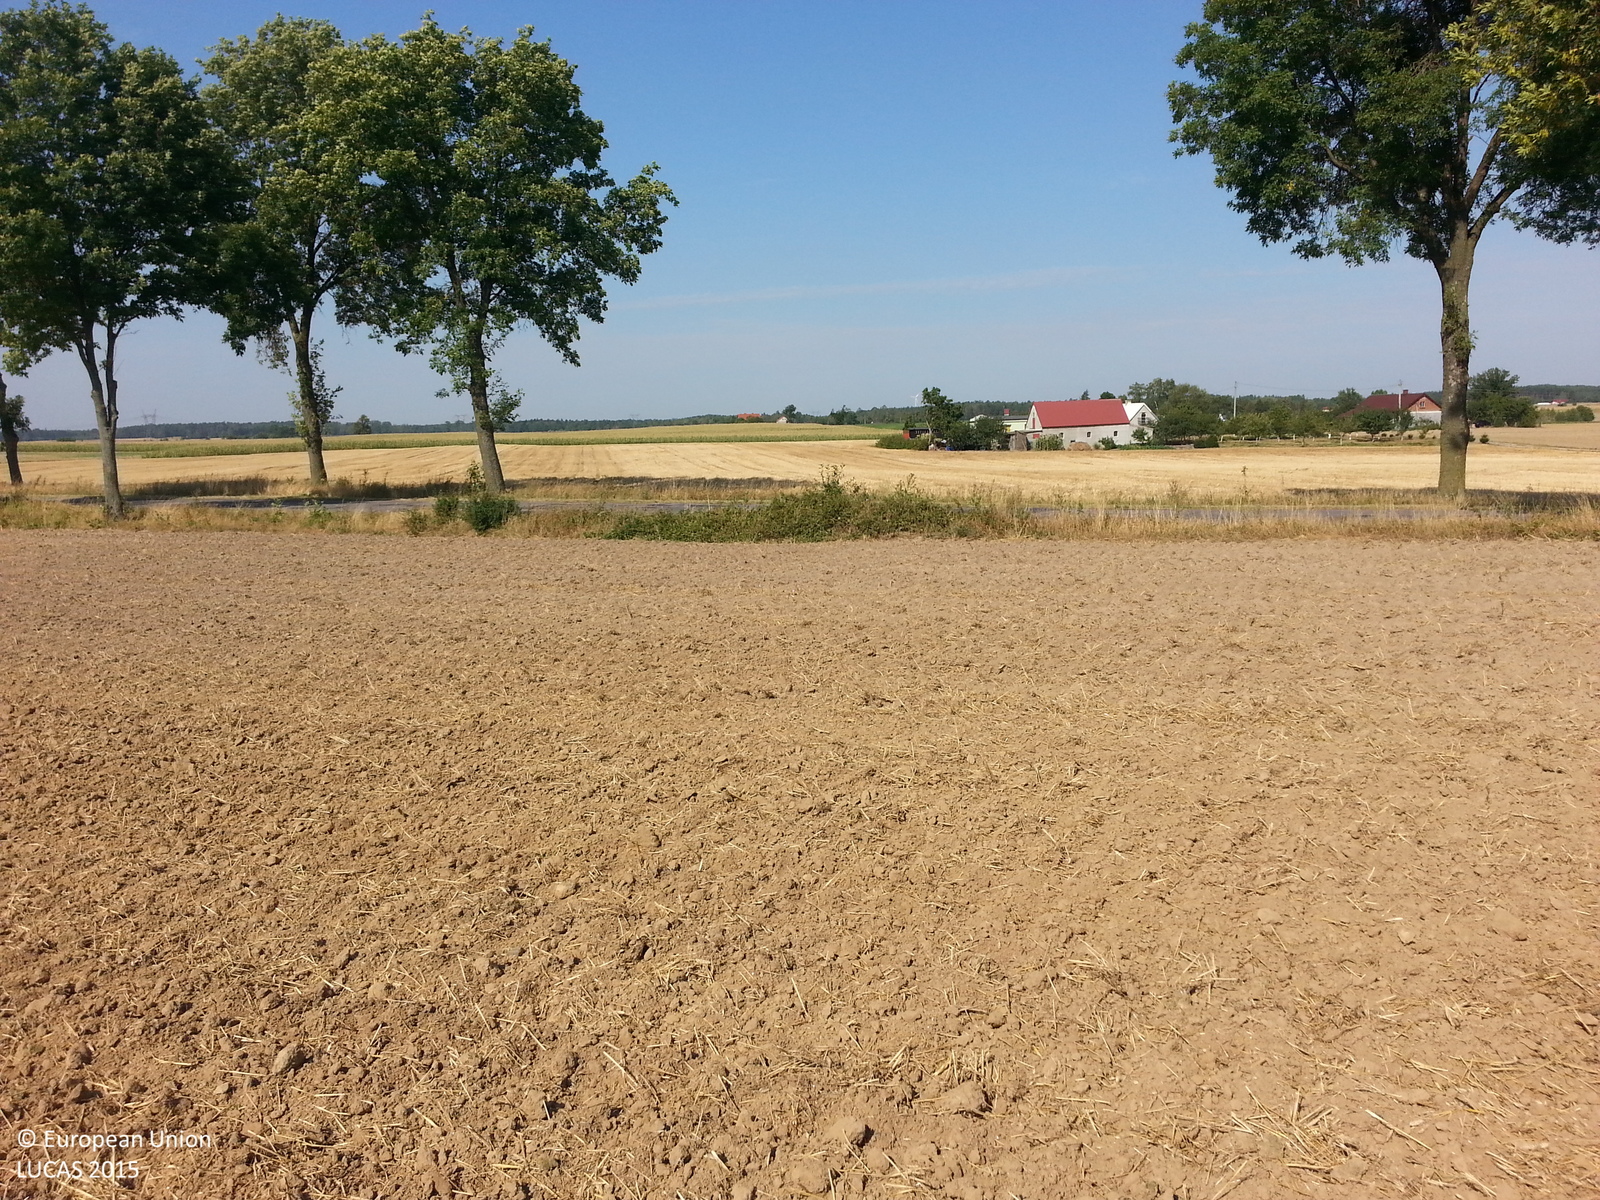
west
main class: Cropland
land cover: Triticale
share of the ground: > 75 %
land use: Agriculture (excluding fallow land and kitchen gardens)
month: August
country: PL
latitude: 53.0913
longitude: 19.1474
